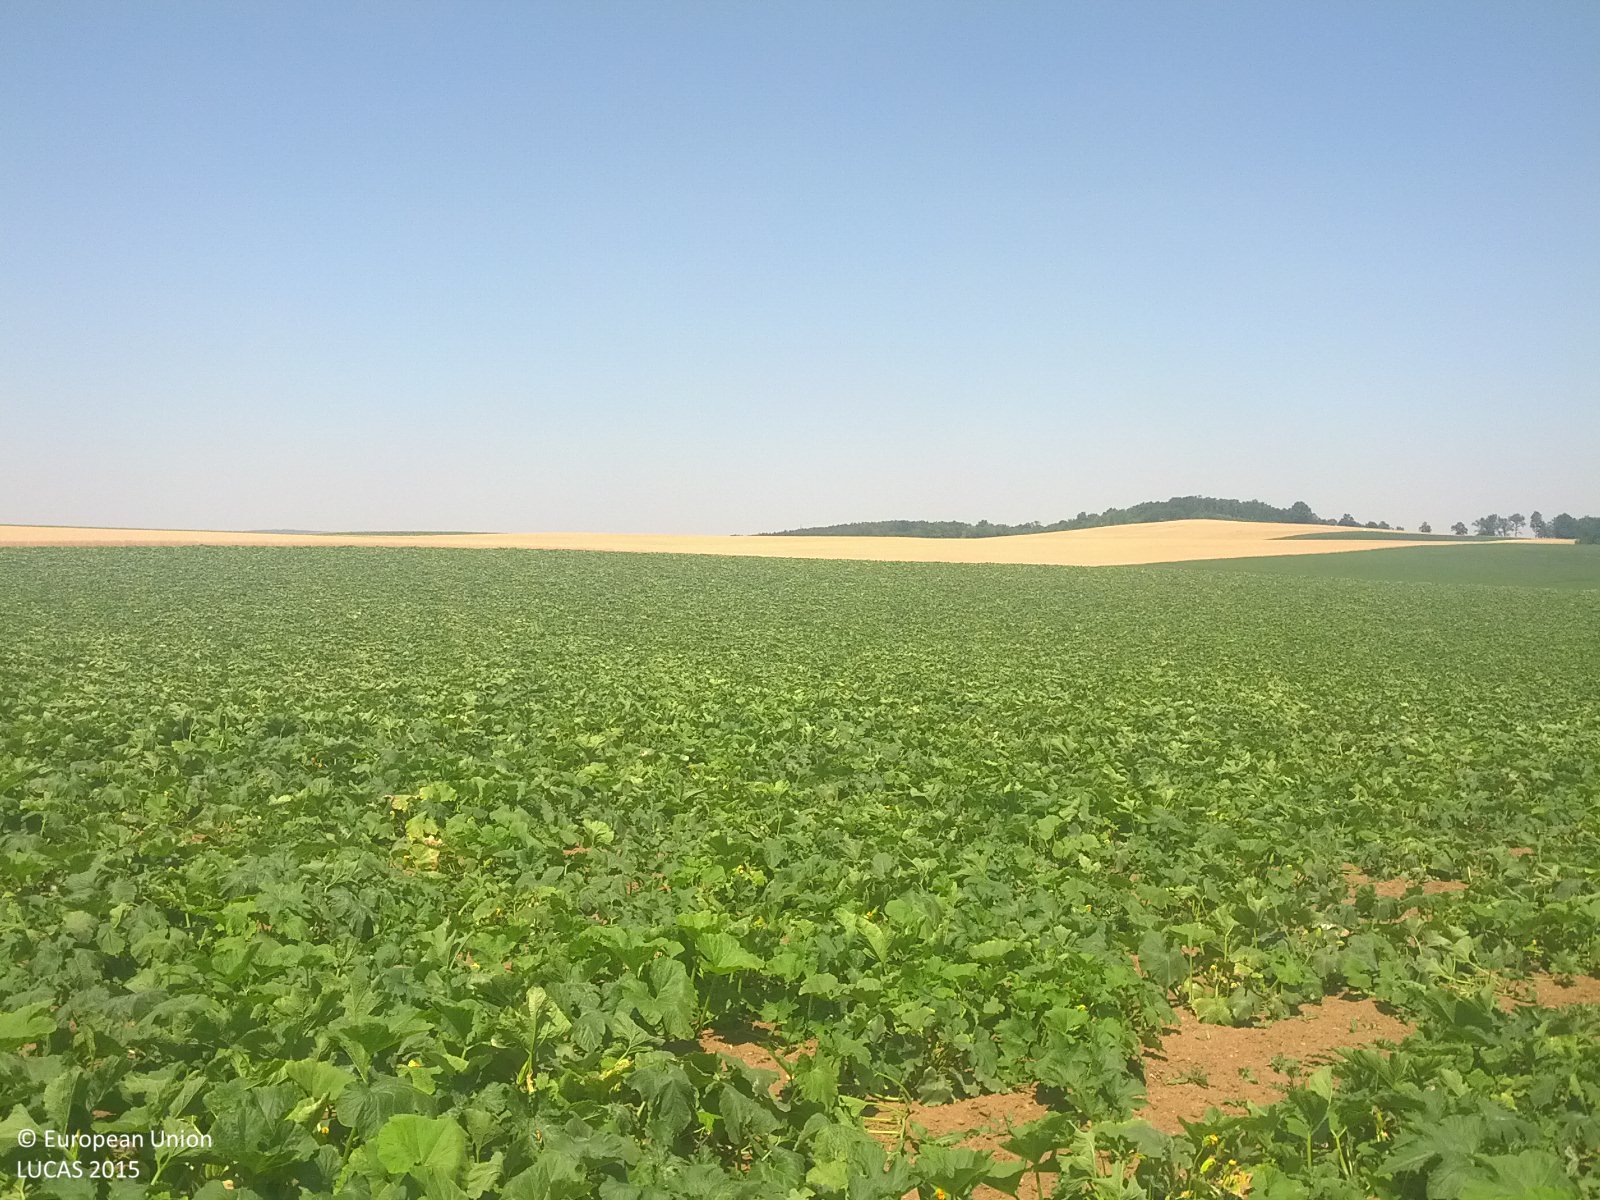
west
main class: Cropland
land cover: Other fresh vegetables
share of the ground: > 75 %
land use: Agriculture (excluding fallow land and kitchen gardens)
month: July
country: AT
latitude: 48.5327
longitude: 16.5744
